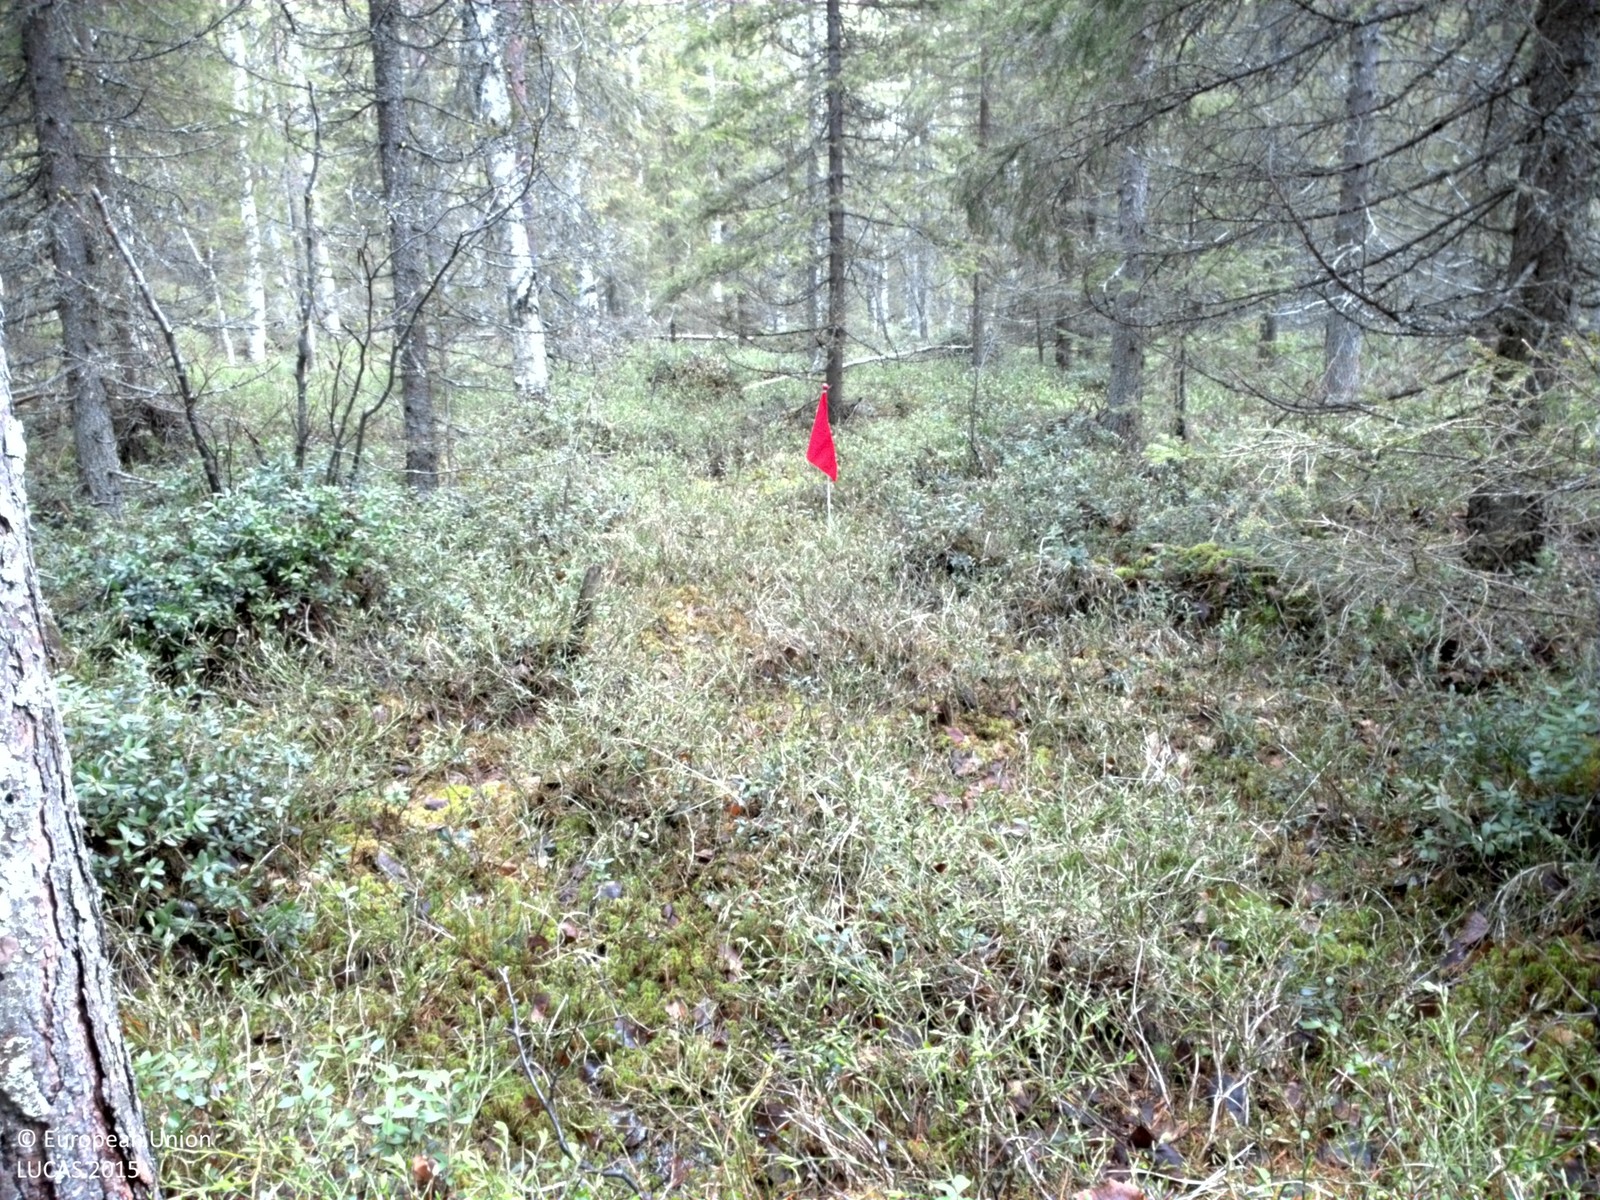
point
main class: Woodland
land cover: Other coniferous woodland
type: boreal forest
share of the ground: > 75 %
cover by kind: coniferous forest trees 65 %, shrubs 25 %, broadleaved forest trees 10 %
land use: Forestry
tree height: > 5 m
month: June
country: SE
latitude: 66.4170
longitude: 23.4465
